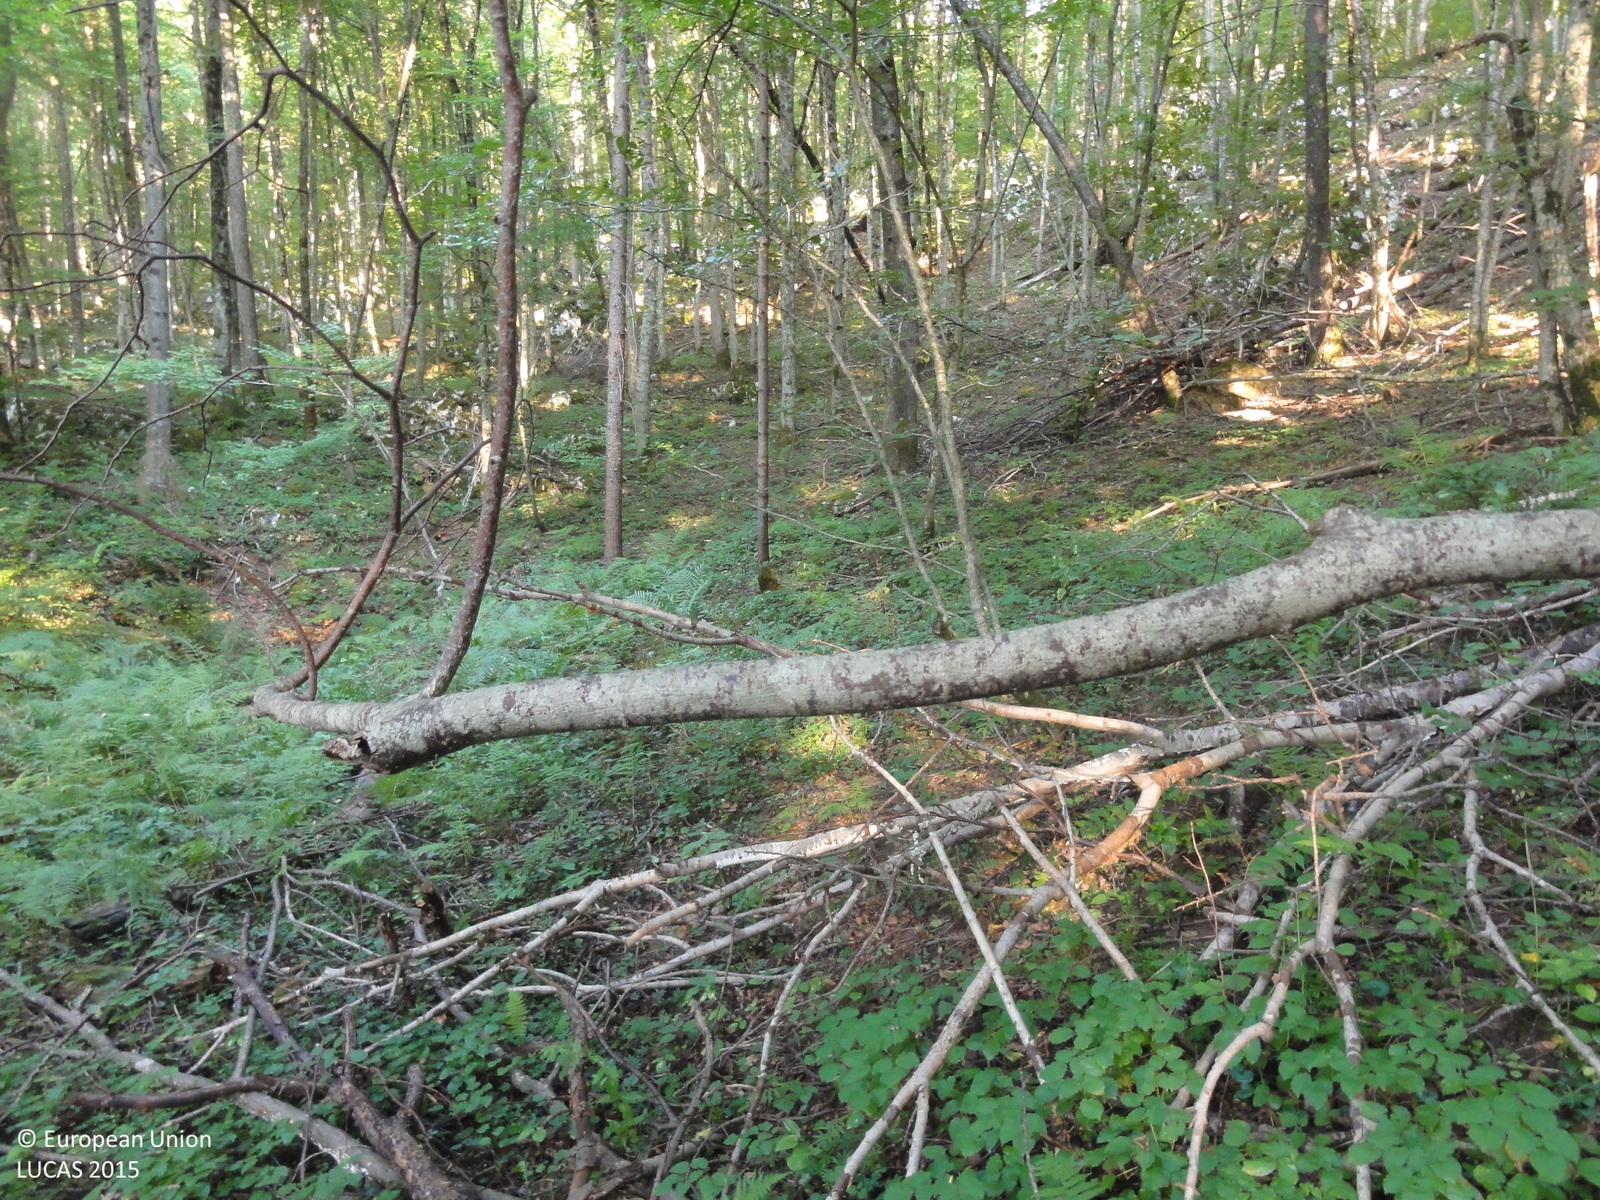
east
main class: Woodland
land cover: Broadleaved woodland
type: beech forest
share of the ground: > 75 %
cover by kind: broadleaved forest trees 95 %, coniferous forest trees 5 %
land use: Forestry
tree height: > 5 m
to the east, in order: Broadleaved woodland; Tracks; Broadleaved woodland; Spruce dominated mixed woodland
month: August
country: SI
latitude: 45.8370
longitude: 15.0047
